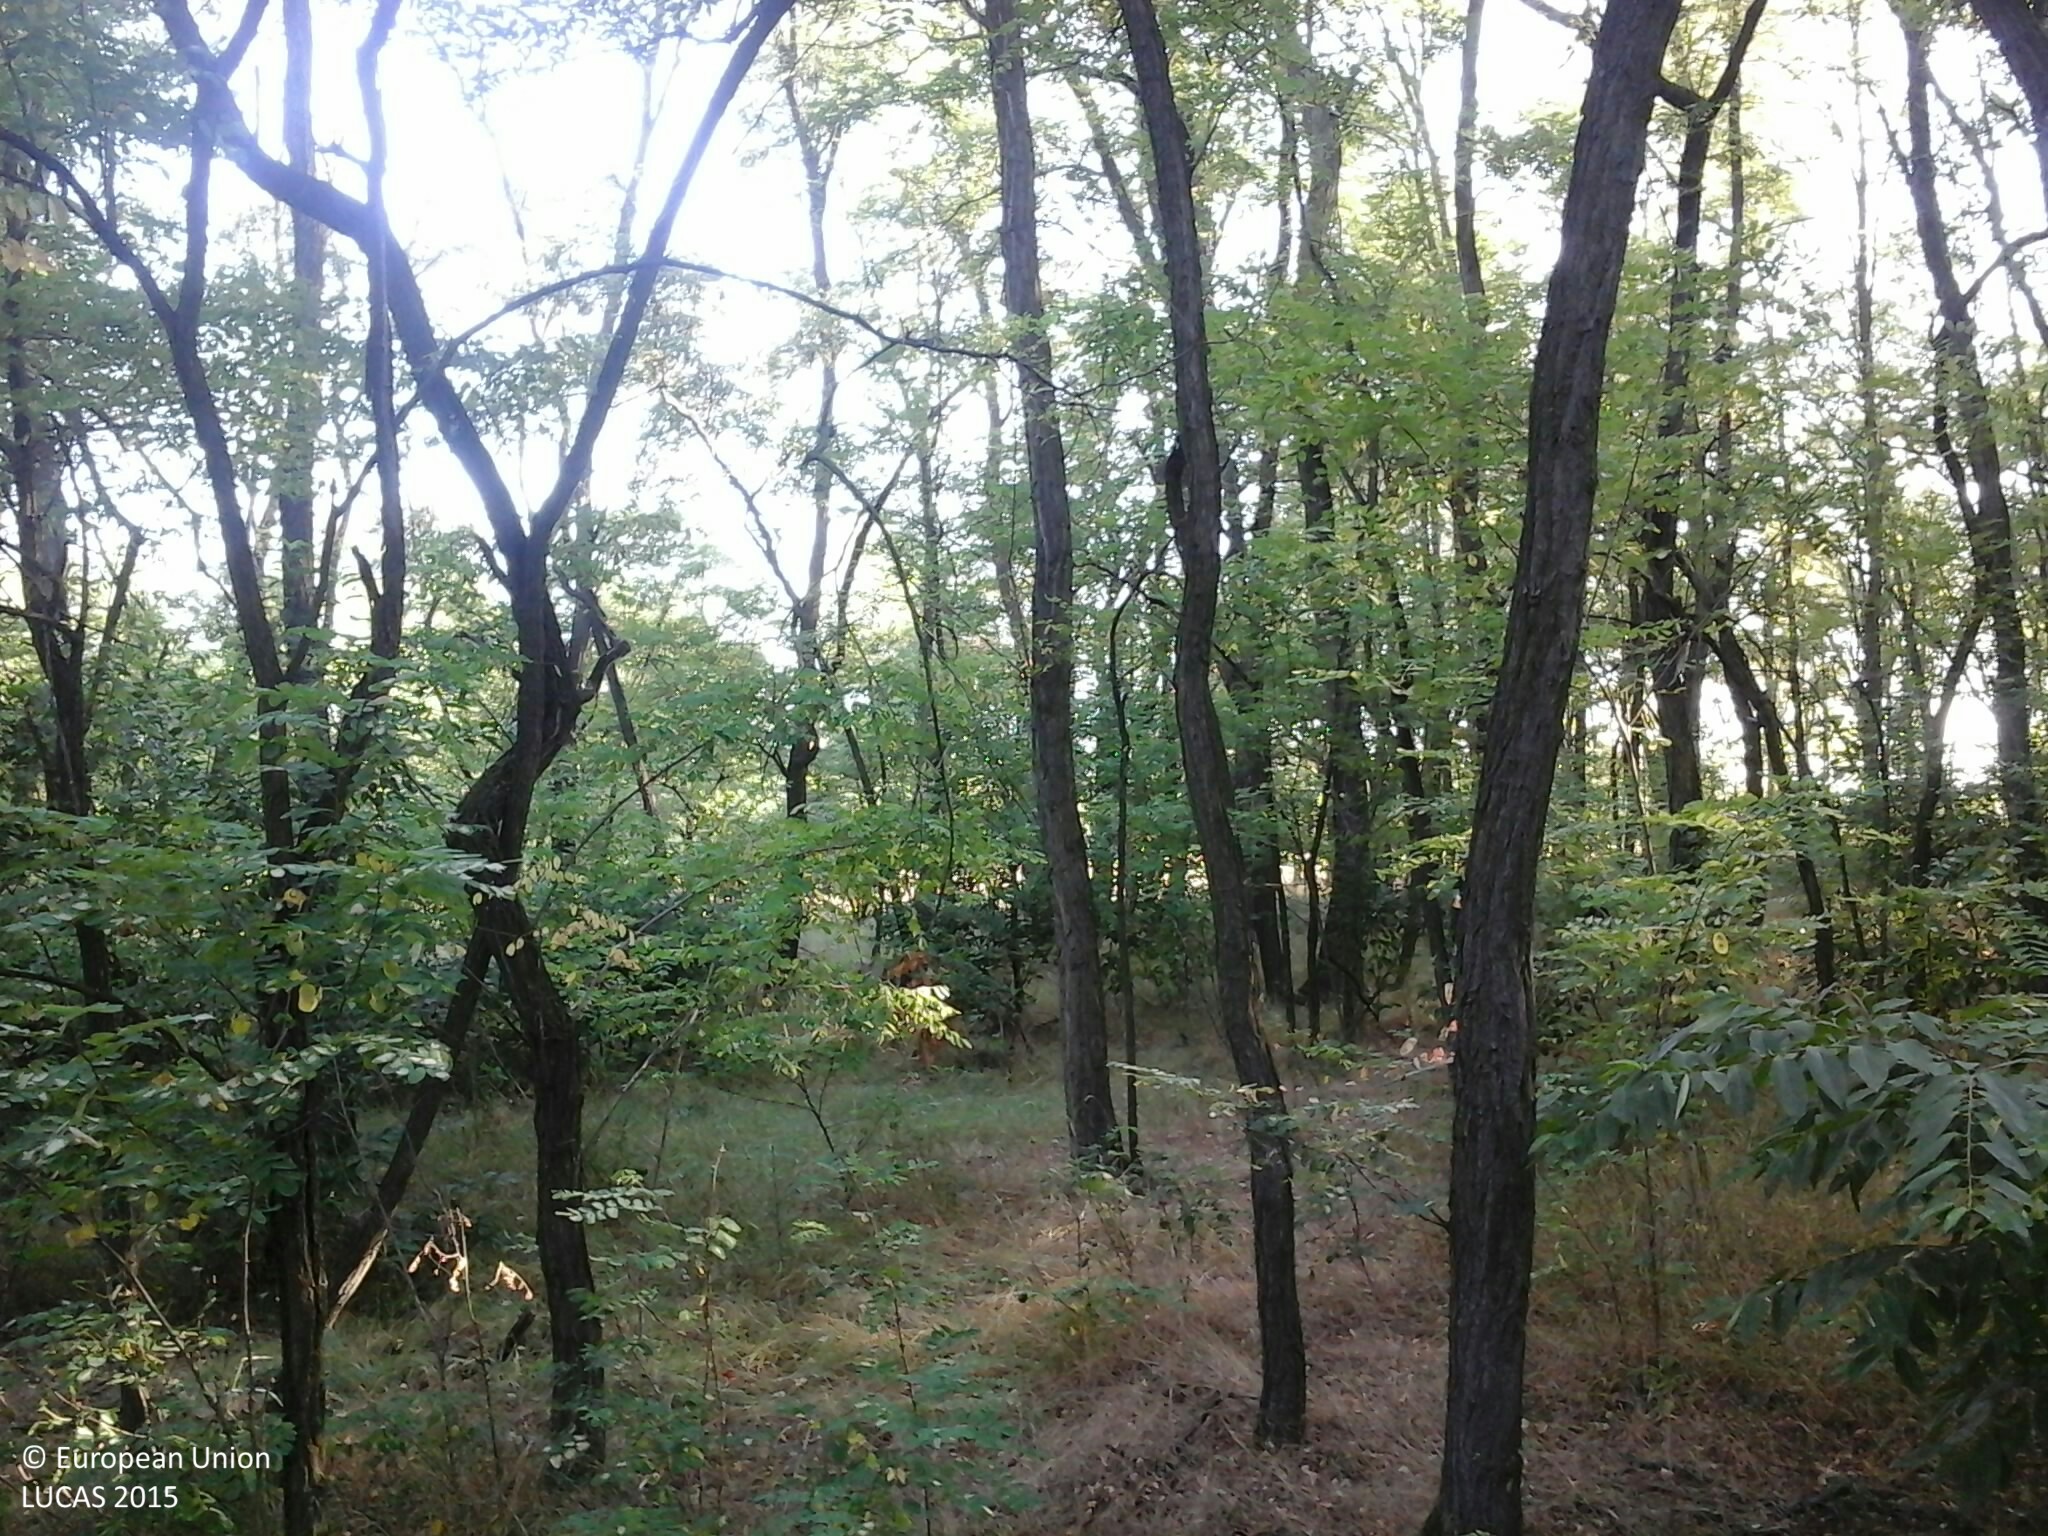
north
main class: Woodland
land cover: Broadleaved woodland
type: exotic forest
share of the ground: > 75 %
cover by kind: broadleaved forest trees 80 %, herbaceous plants 15 %, shrubs 5 %
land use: Forestry
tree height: > 5 m
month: July
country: HU
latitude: 47.6630
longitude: 22.1032
